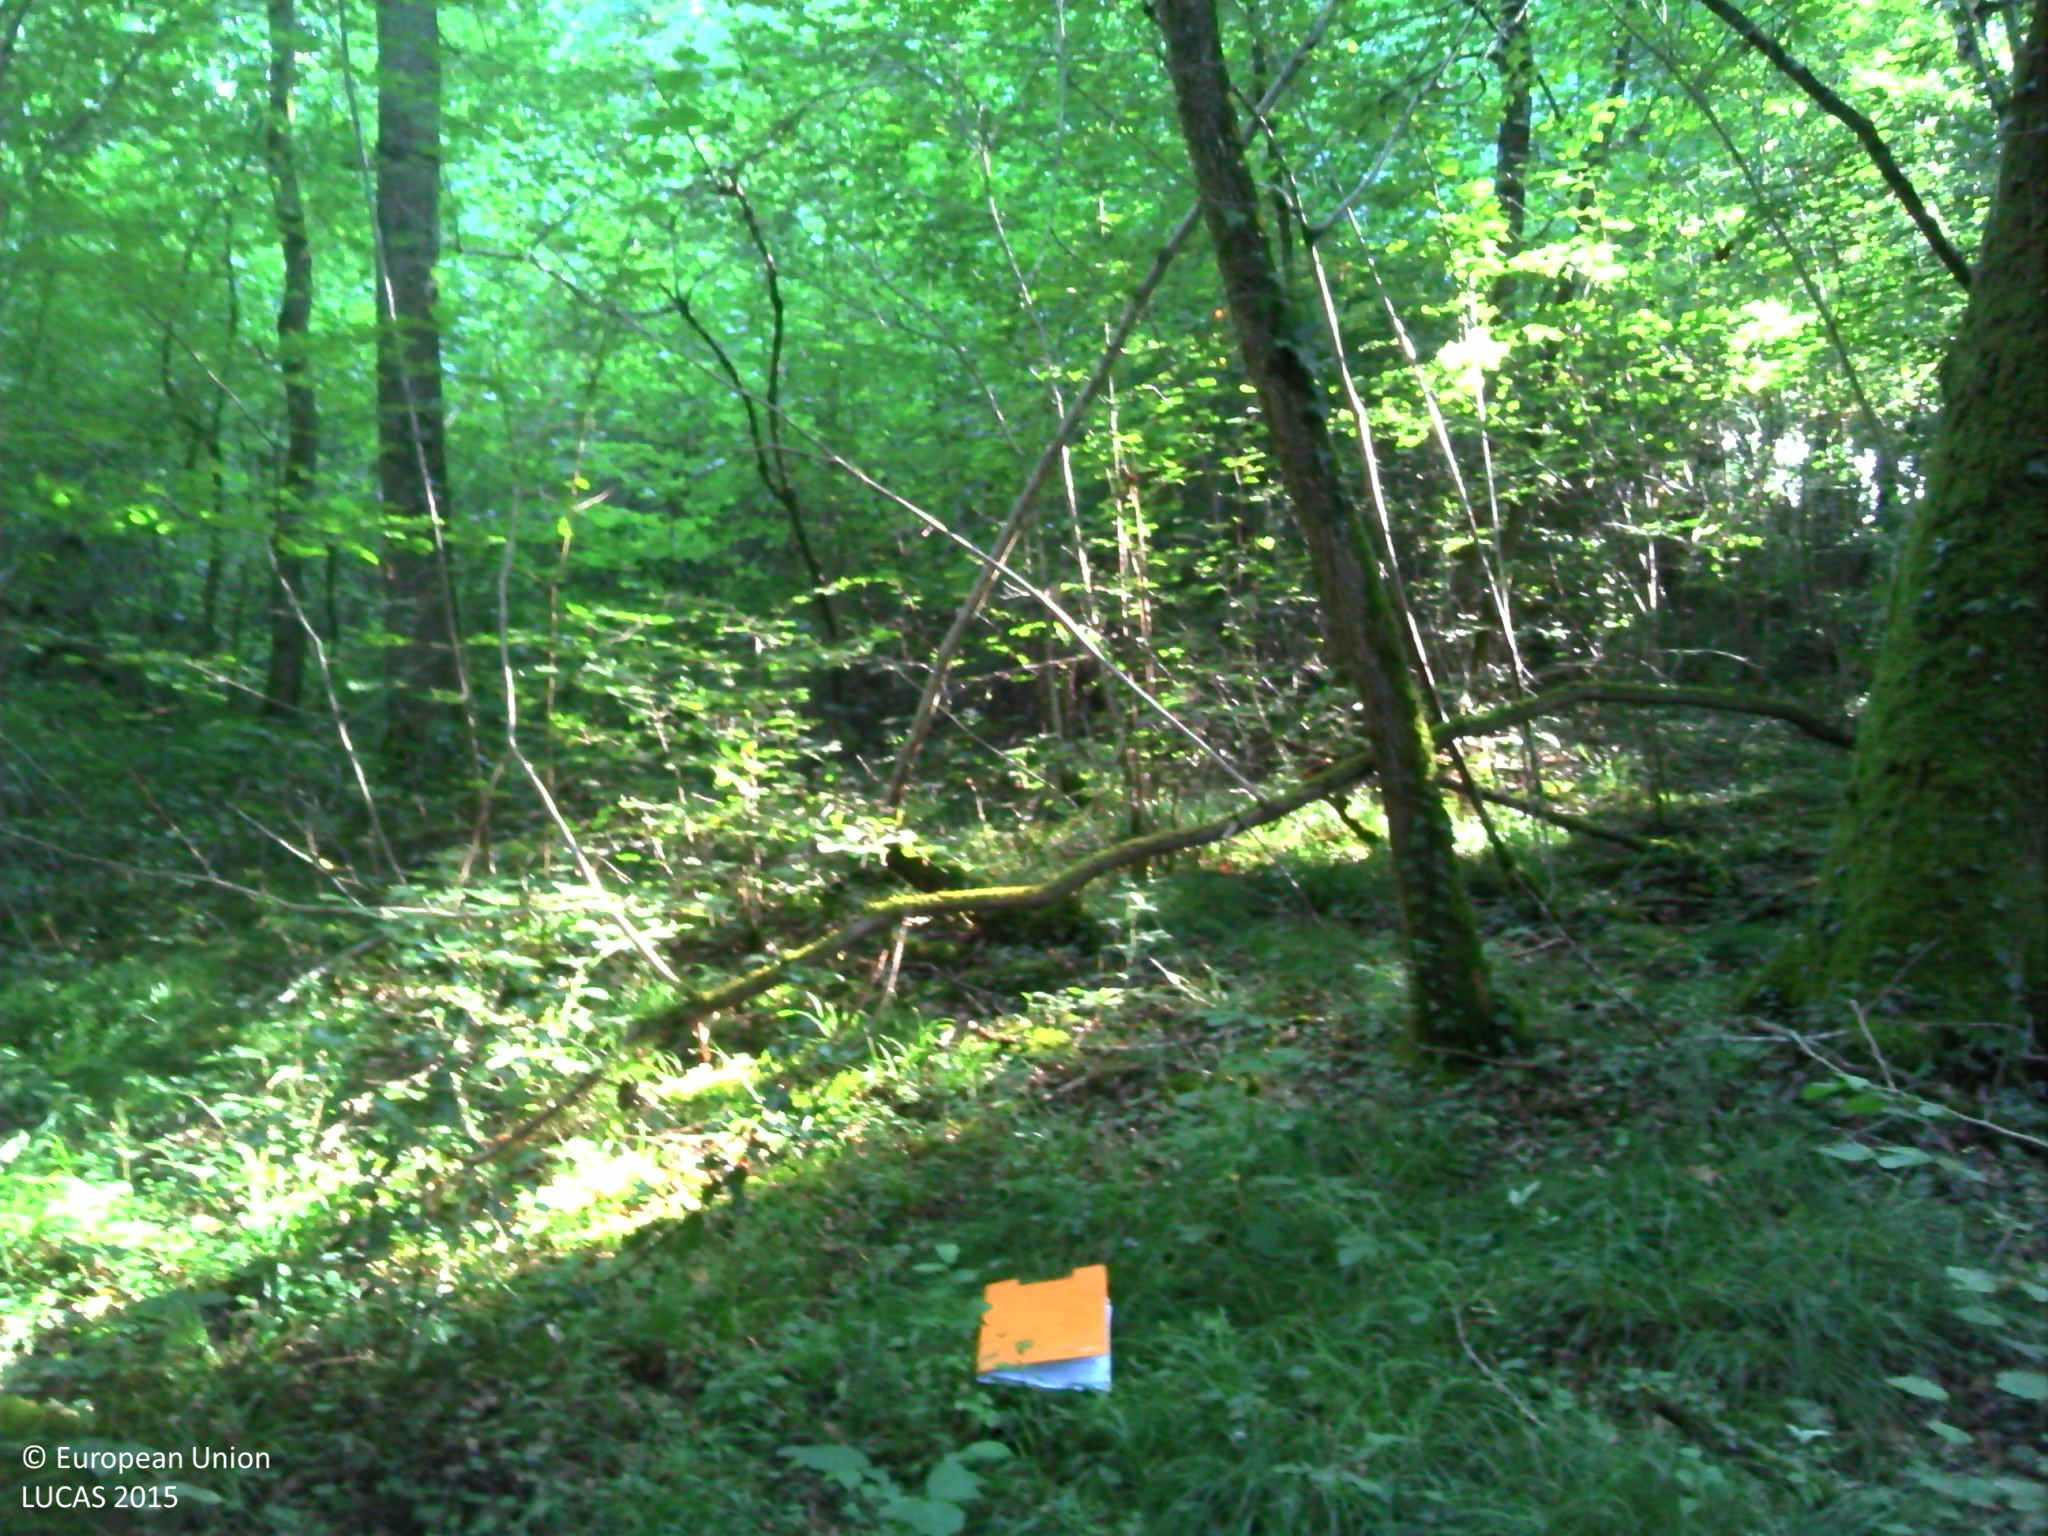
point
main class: Woodland
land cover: Broadleaved woodland
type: mesophytic deciduous forest
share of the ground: > 75 %
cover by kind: broadleaved forest trees 100 %
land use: Forestry
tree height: > 5 m
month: August
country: FR
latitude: 47.1793
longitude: 2.0868
